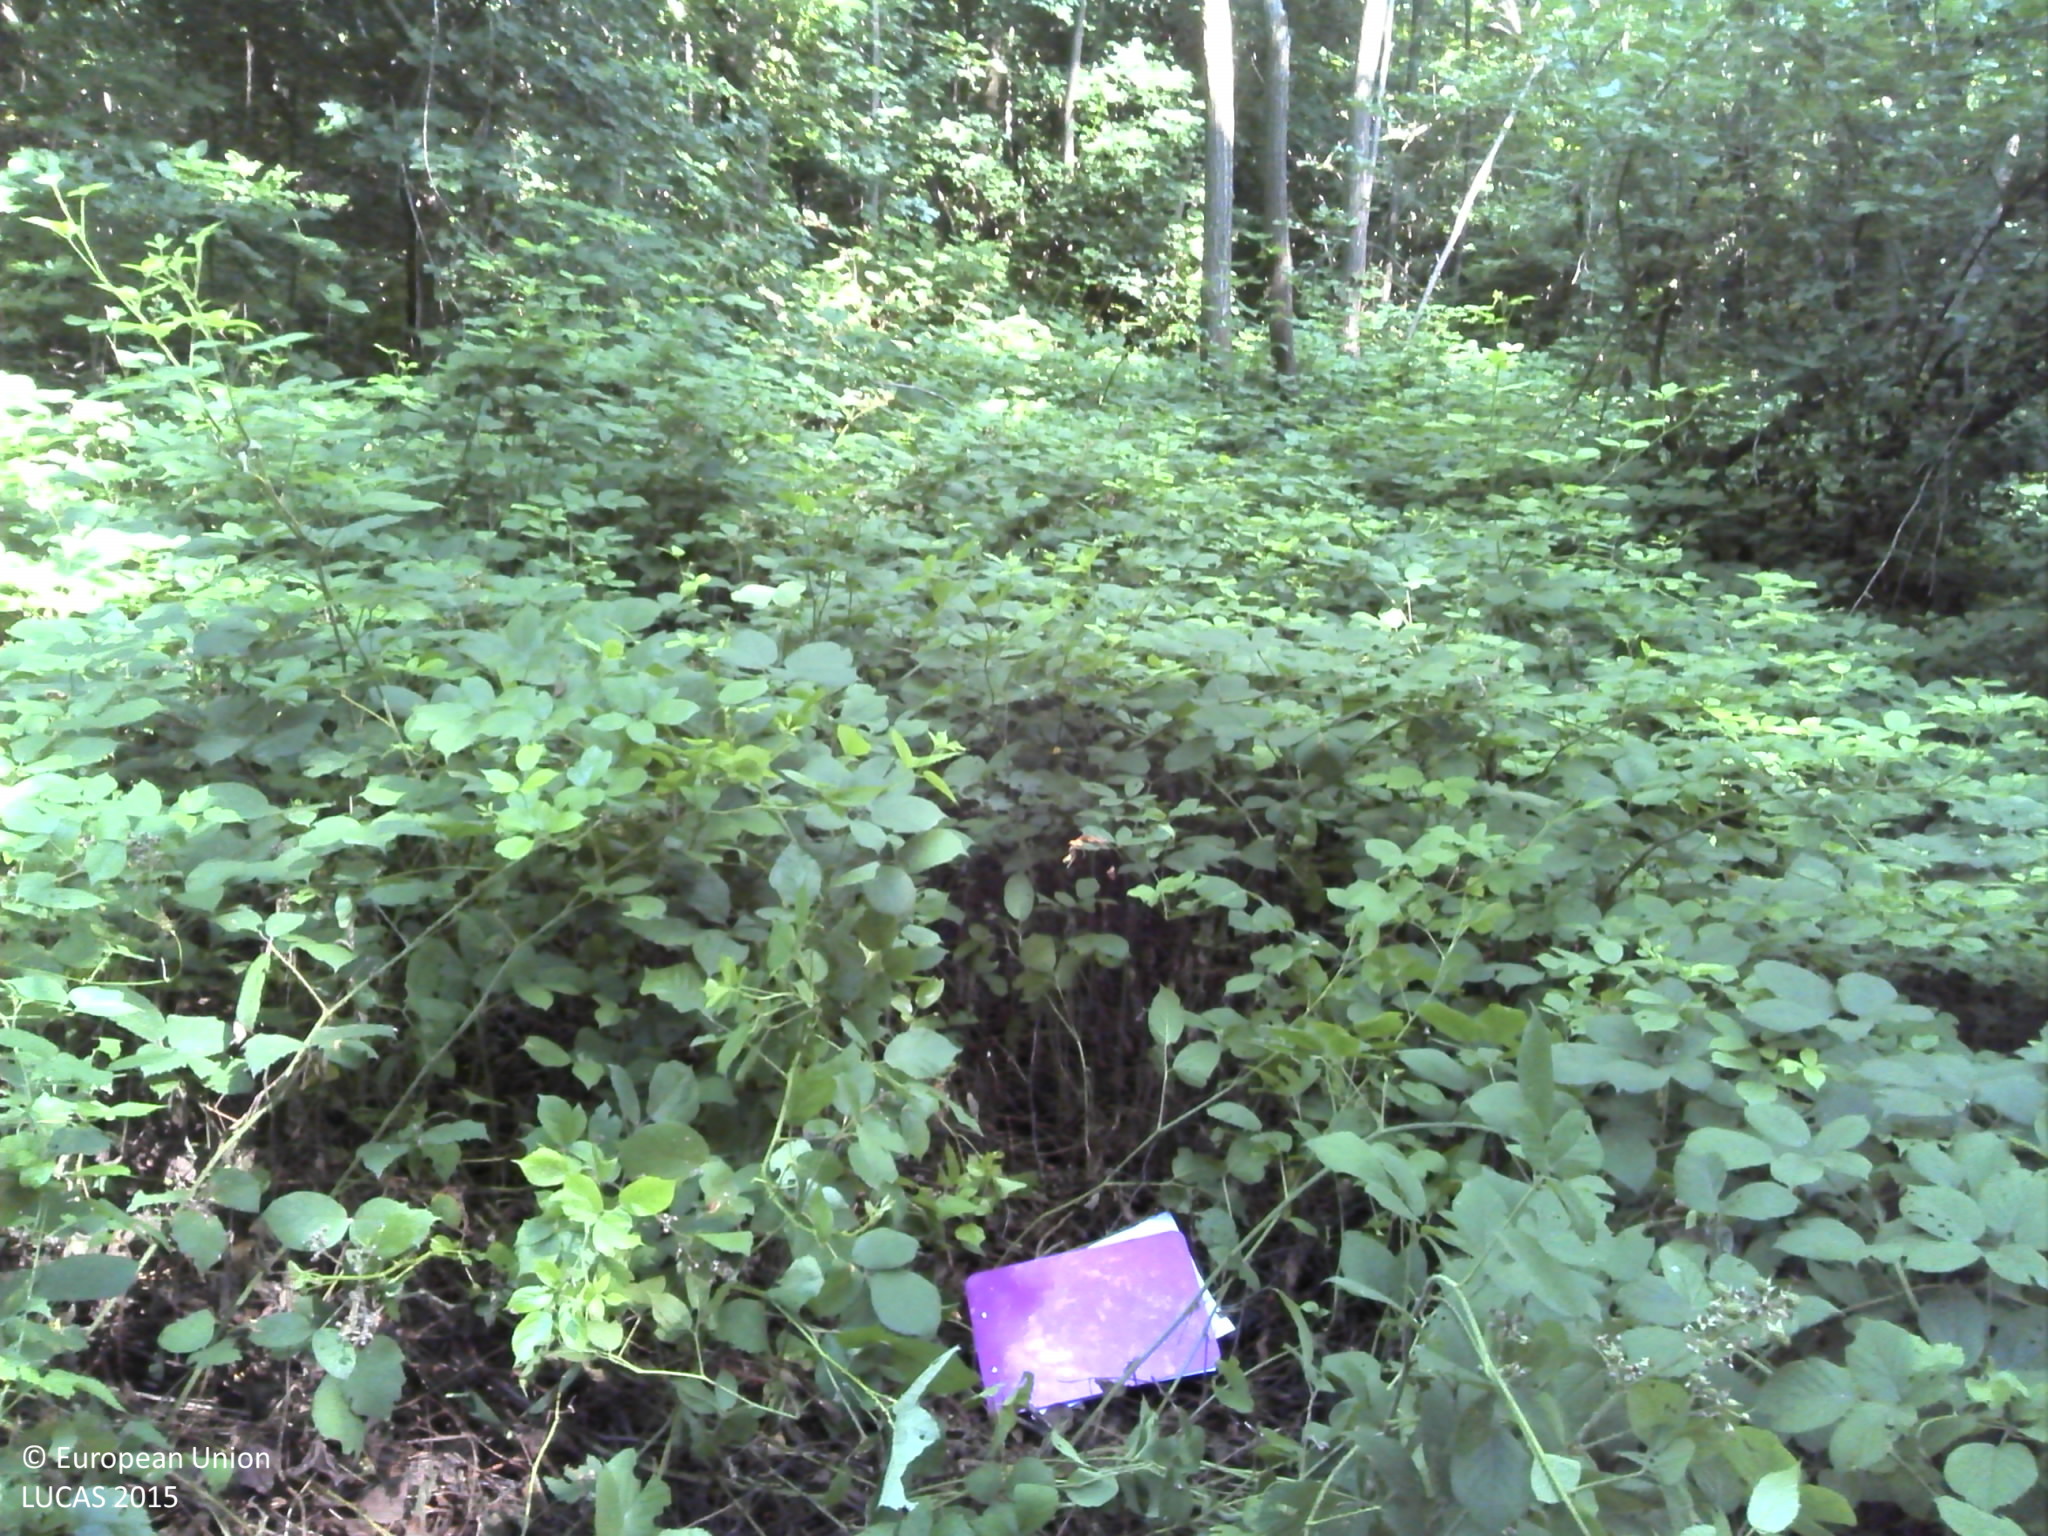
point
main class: Woodland
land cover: Broadleaved woodland
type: acidophilous oak and oak-birch forest
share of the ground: > 75 %
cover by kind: broadleaved forest trees 100 %
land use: Forestry
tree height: > 5 m
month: June
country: HR
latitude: 45.2802
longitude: 17.4070
